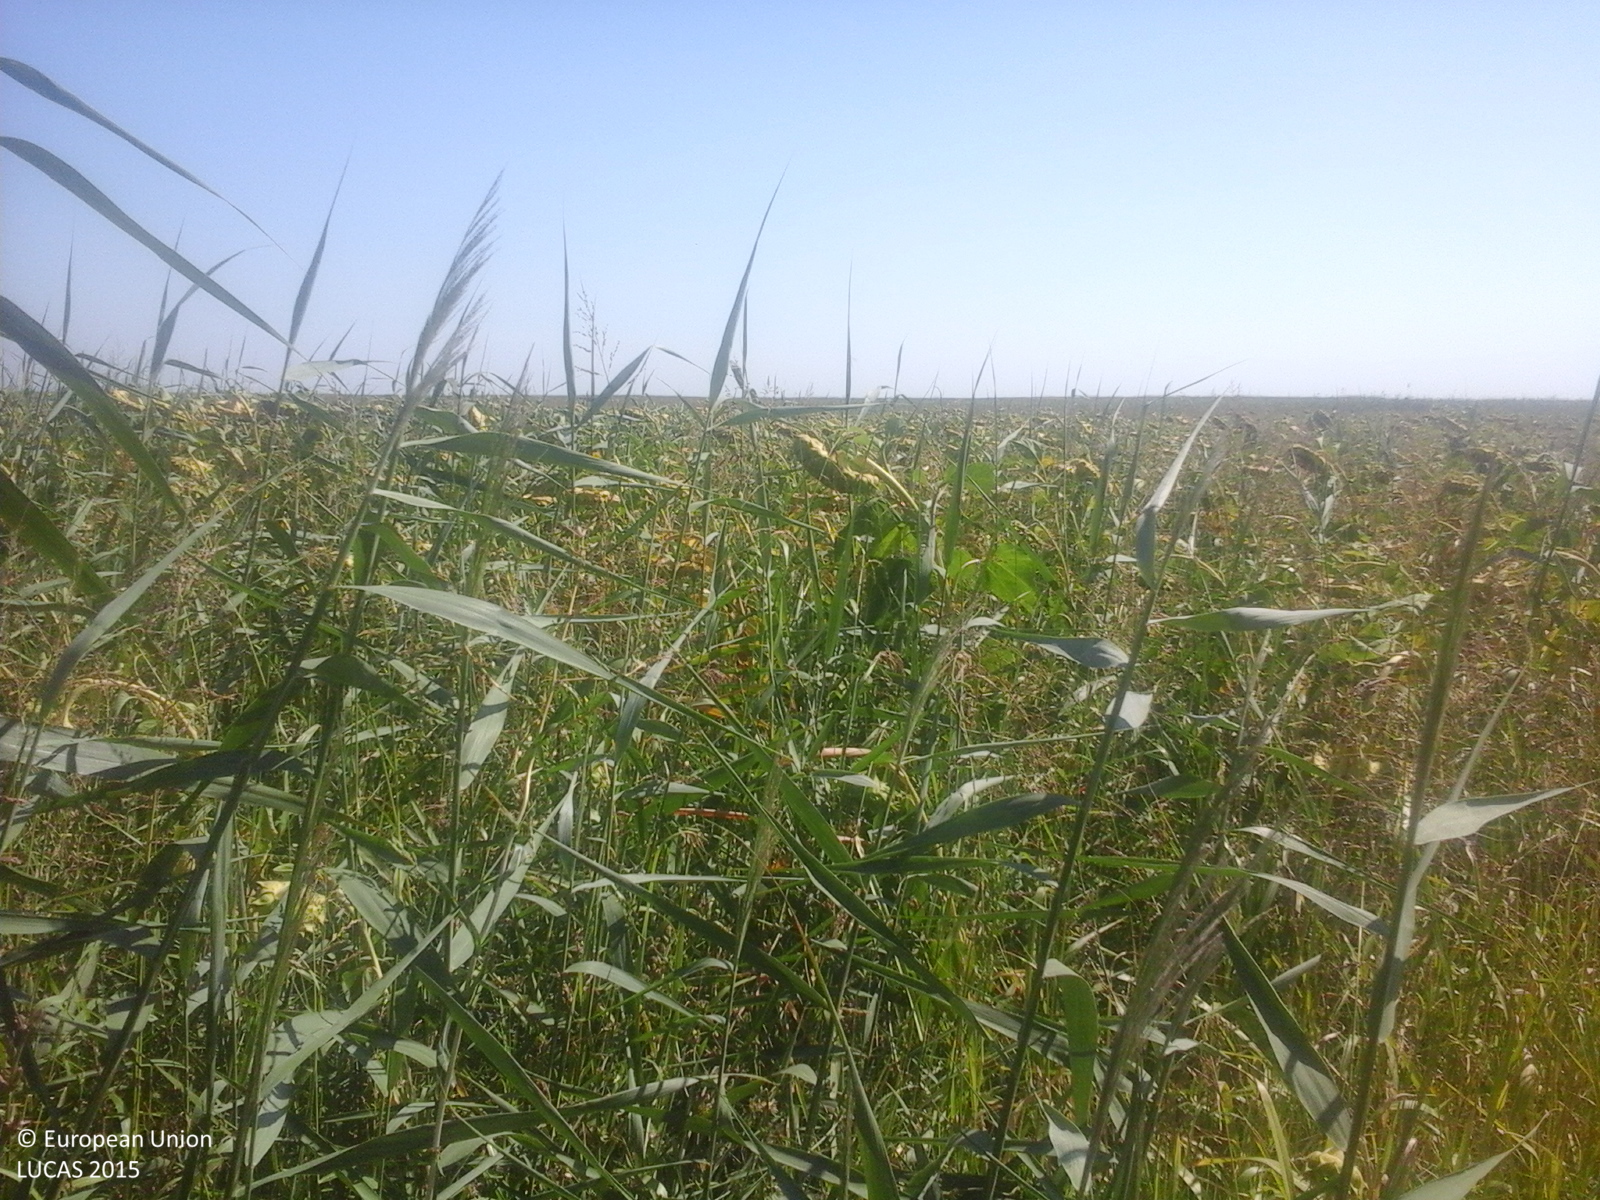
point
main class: Cropland
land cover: Sunflower
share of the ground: > 75 %
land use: Agriculture (excluding fallow land and kitchen gardens)
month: August
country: RO
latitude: 45.5632
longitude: 27.4620
